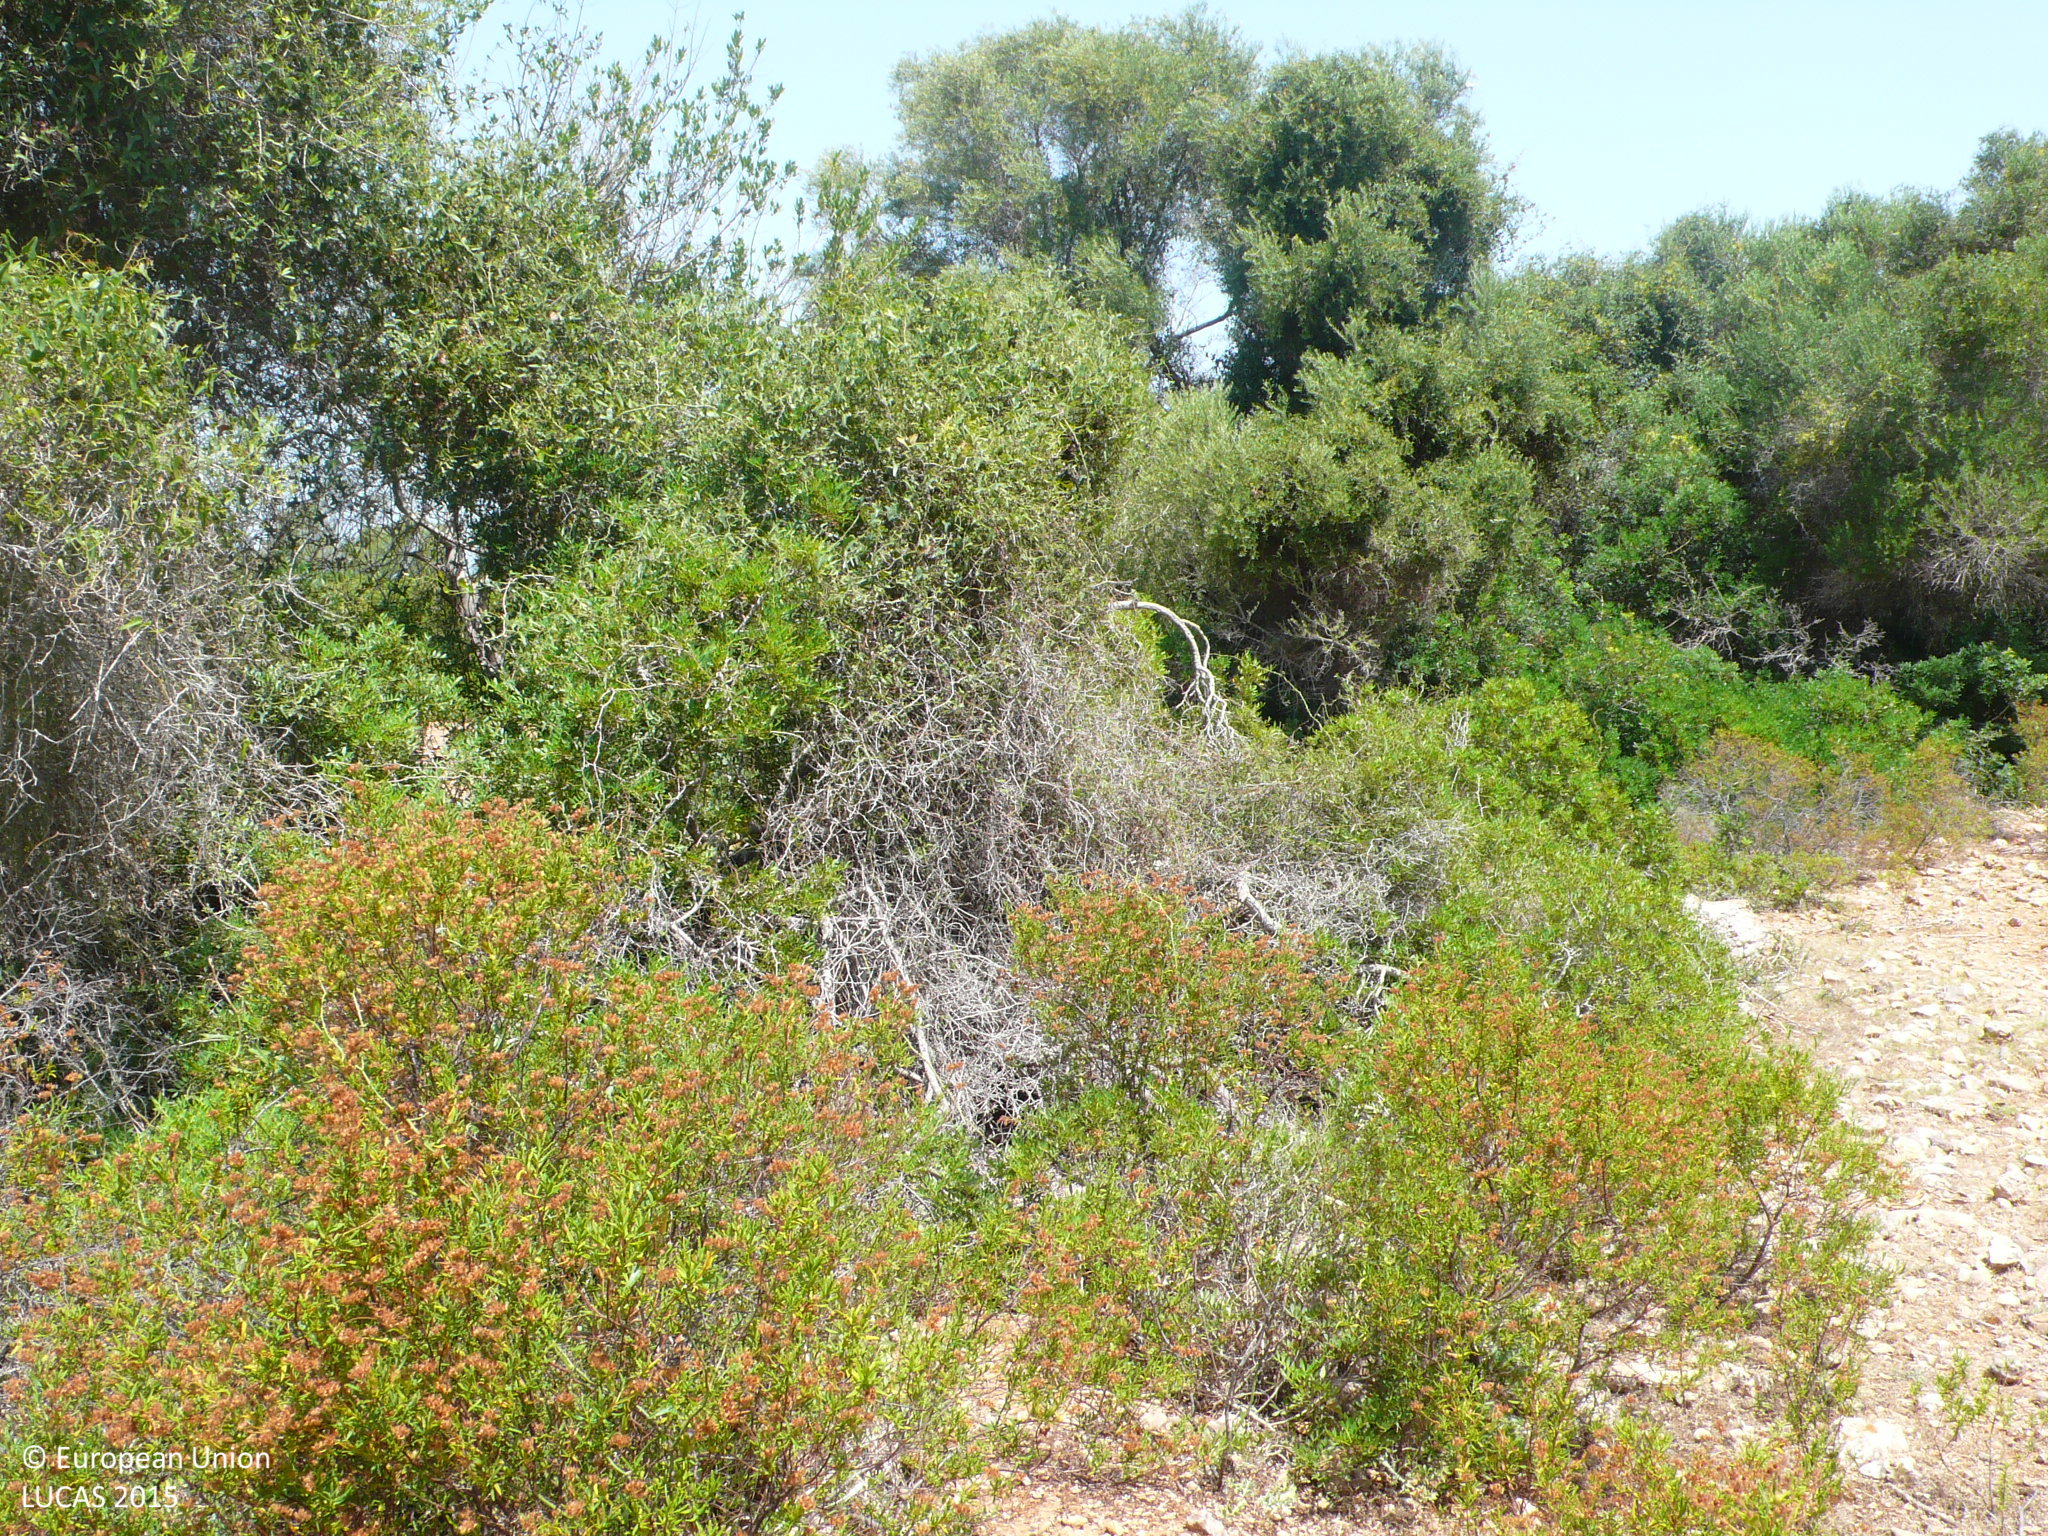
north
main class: Woodland
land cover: Broadleaved woodland
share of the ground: 50 - 75 %
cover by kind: broadleaved forest trees 50 %, shrubs 35 %, herbaceous plants 10 %, consolidated bare surface 5 %
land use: Semi-natural and natural areas not in use
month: July
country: ES
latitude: 39.6899
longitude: 3.2543
